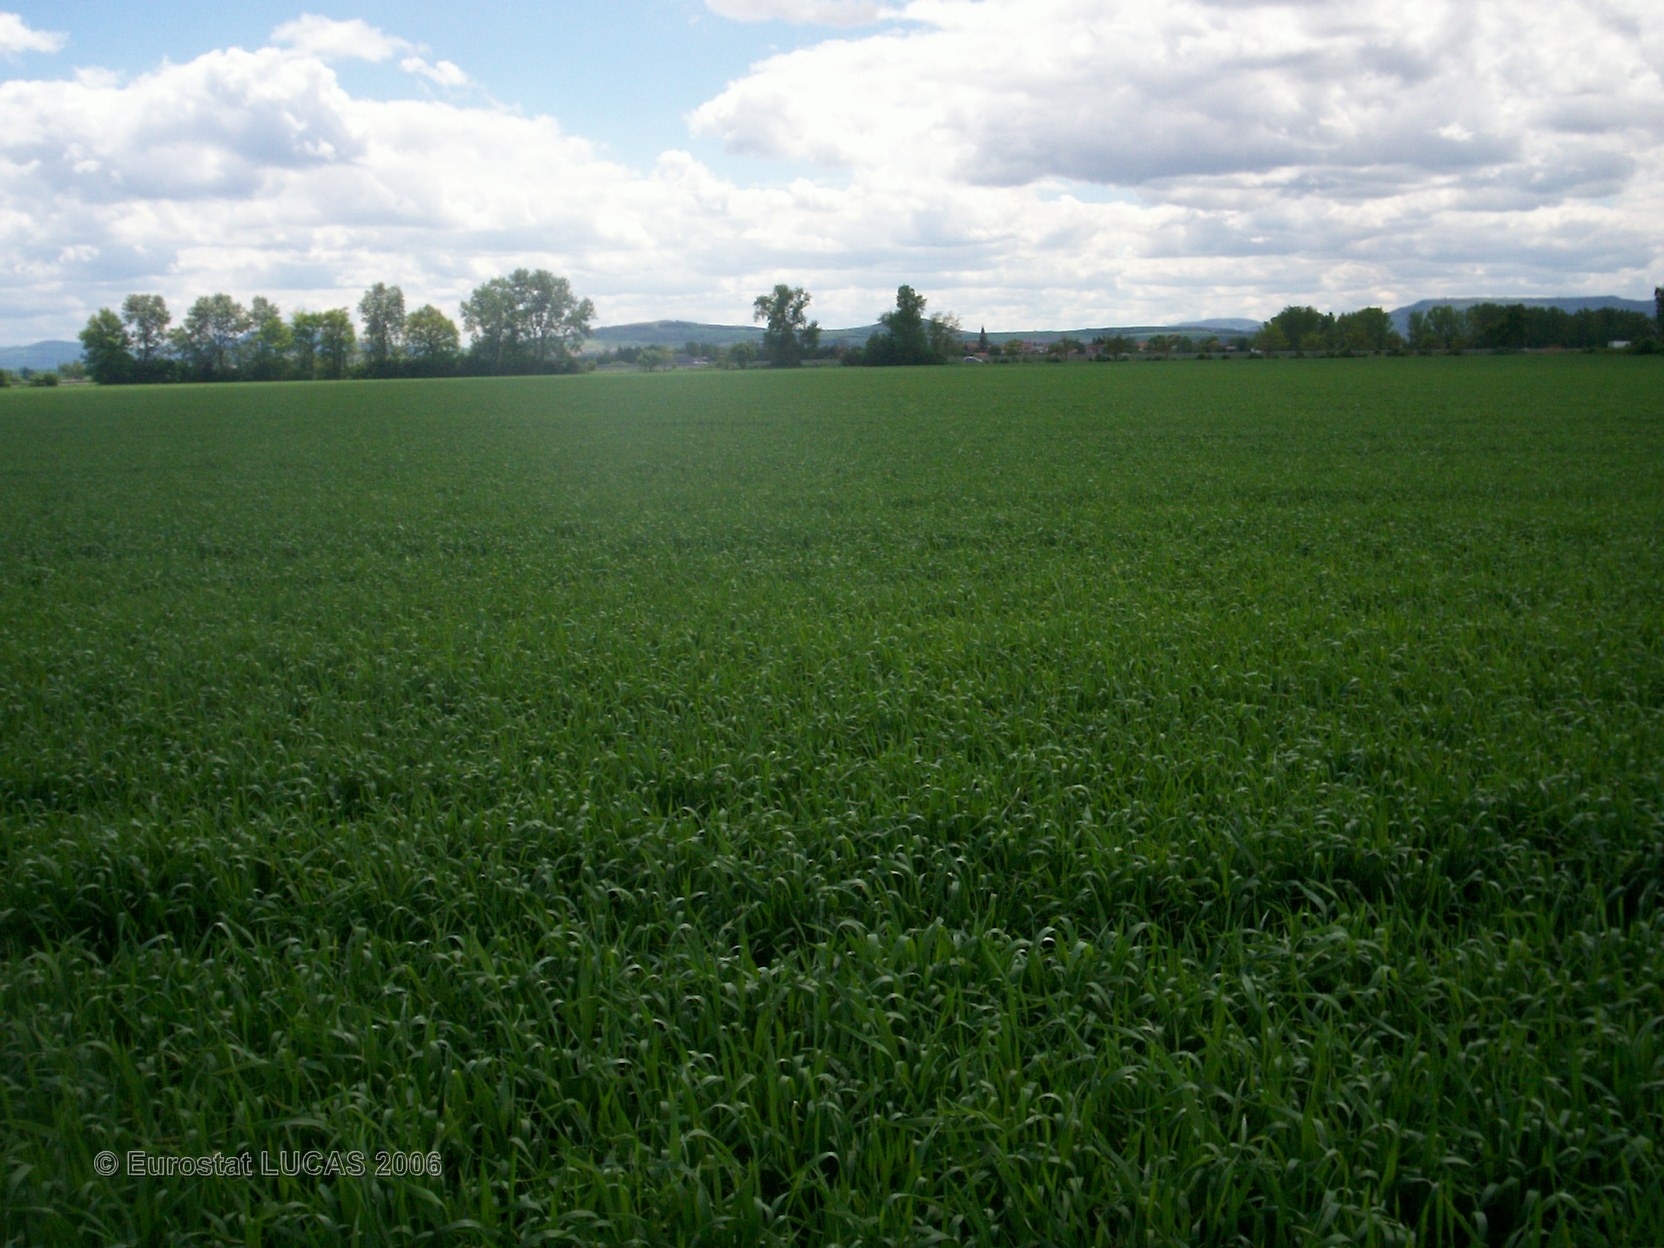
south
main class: Cropland
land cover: Common wheat
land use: Agriculture (excluding fallow land and kitchen gardens)
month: May
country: FR
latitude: 45.8268
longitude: 3.1904
